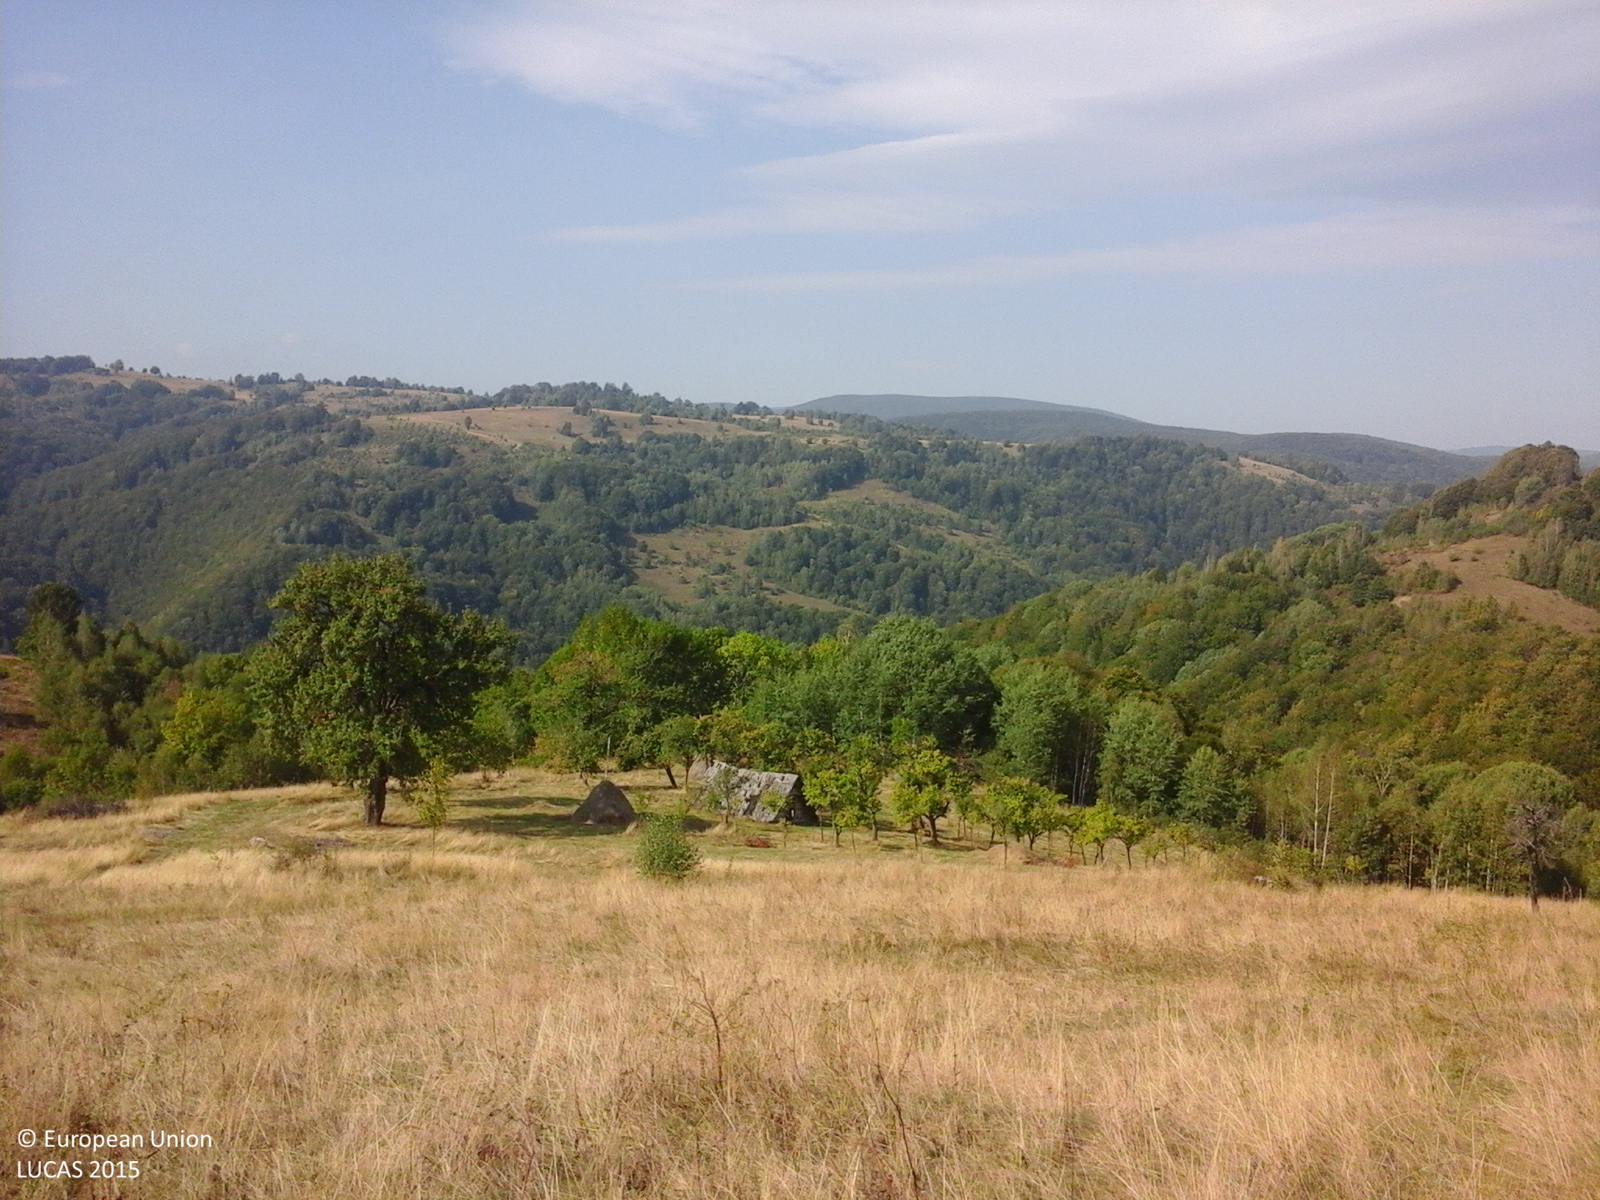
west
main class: Grassland
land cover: Spontaneously vegetated surfaces
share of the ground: > 75 %
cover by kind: herbaceous plants 100 %
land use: Fallow land
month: September
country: RO
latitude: 45.1893
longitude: 22.2458
